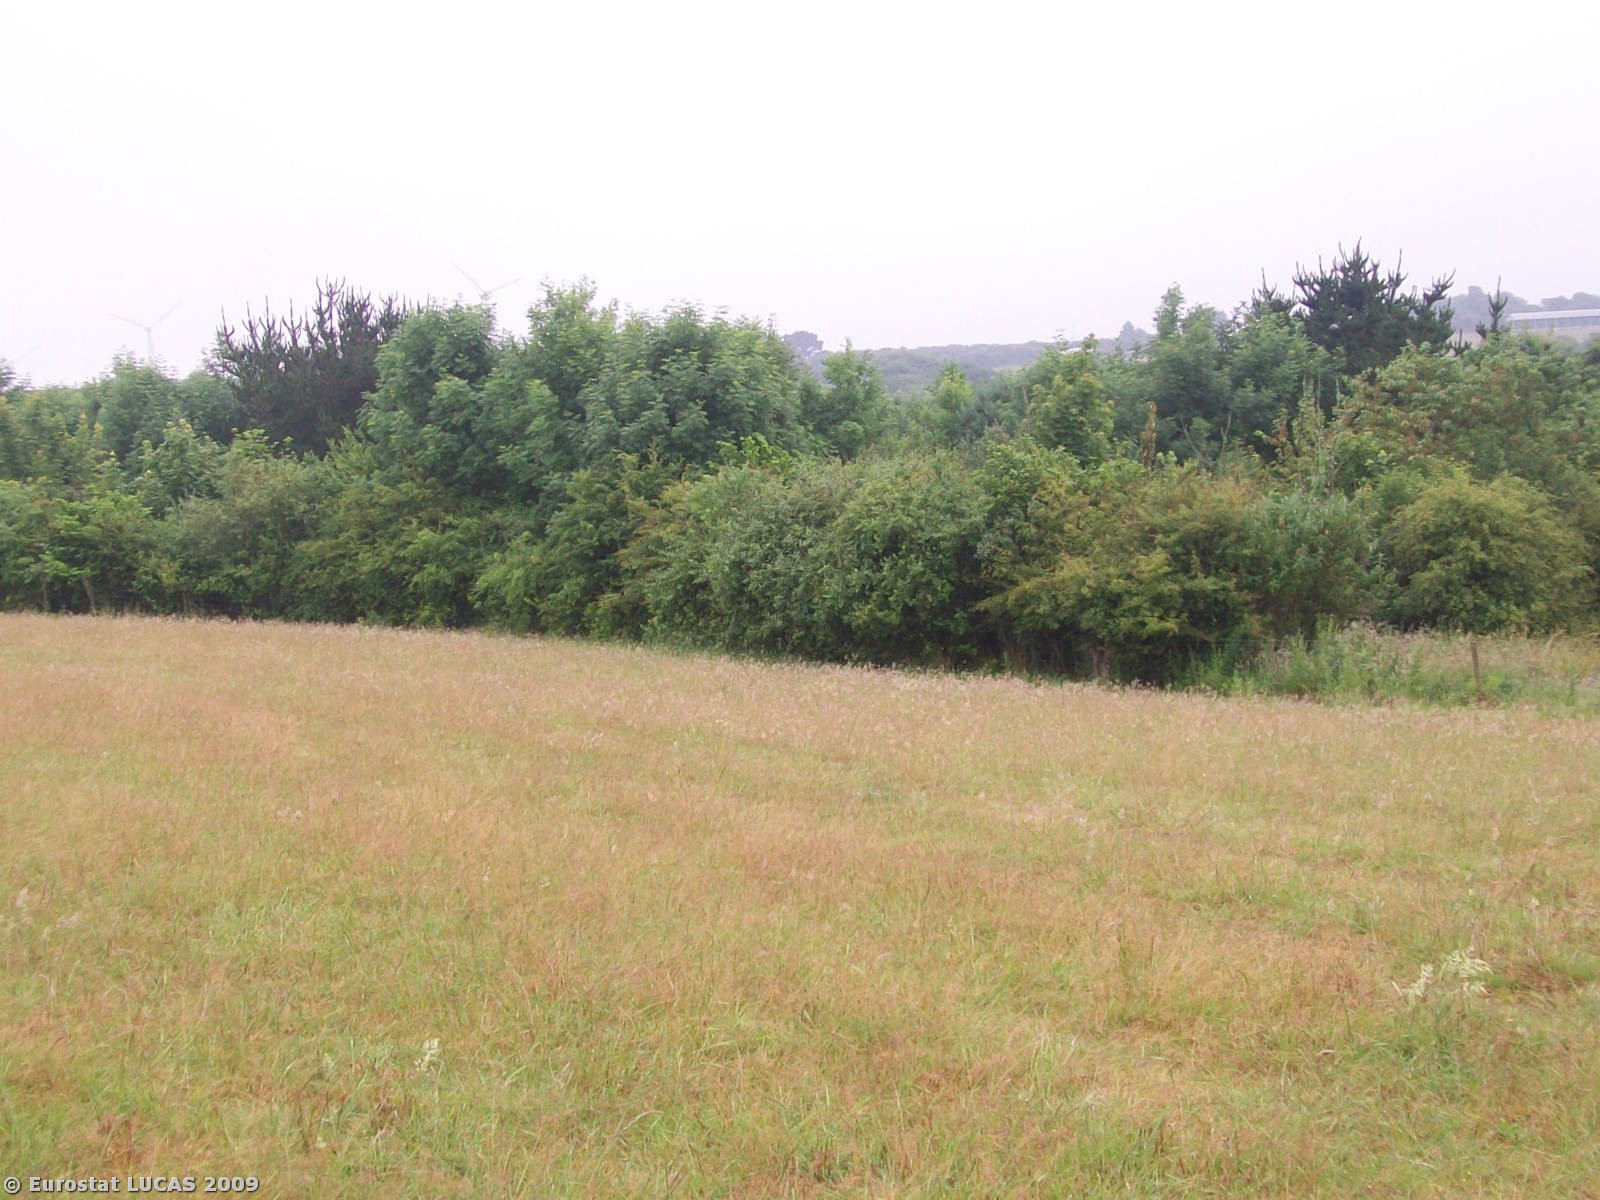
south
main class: Grassland
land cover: Grassland without tree/shrub cover
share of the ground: > 75 %
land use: Agriculture (excluding fallow land and kitchen gardens)
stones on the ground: < 10 %
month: July
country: GB
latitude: 50.3019
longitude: -5.1269
